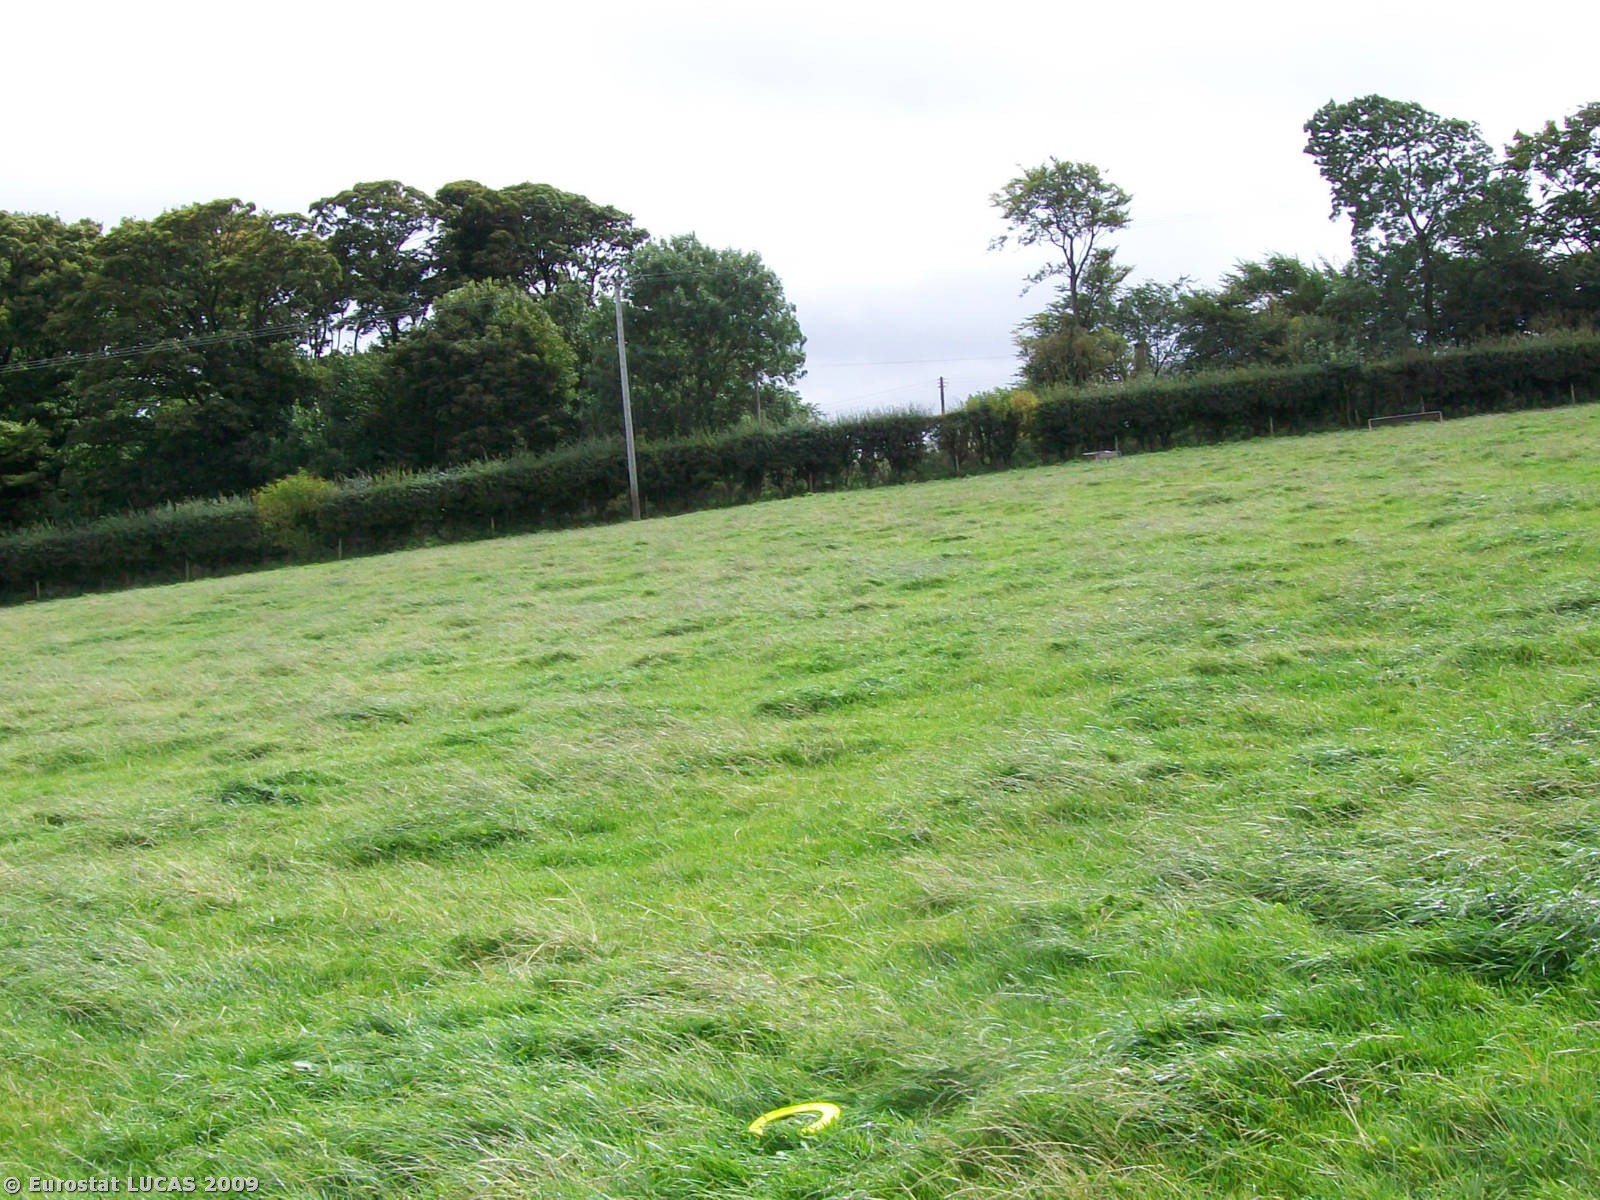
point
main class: Grassland
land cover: Grassland without tree/shrub cover
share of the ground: > 75 %
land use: Agriculture (excluding fallow land and kitchen gardens)
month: September
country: GB
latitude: 55.8621
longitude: -2.3441
